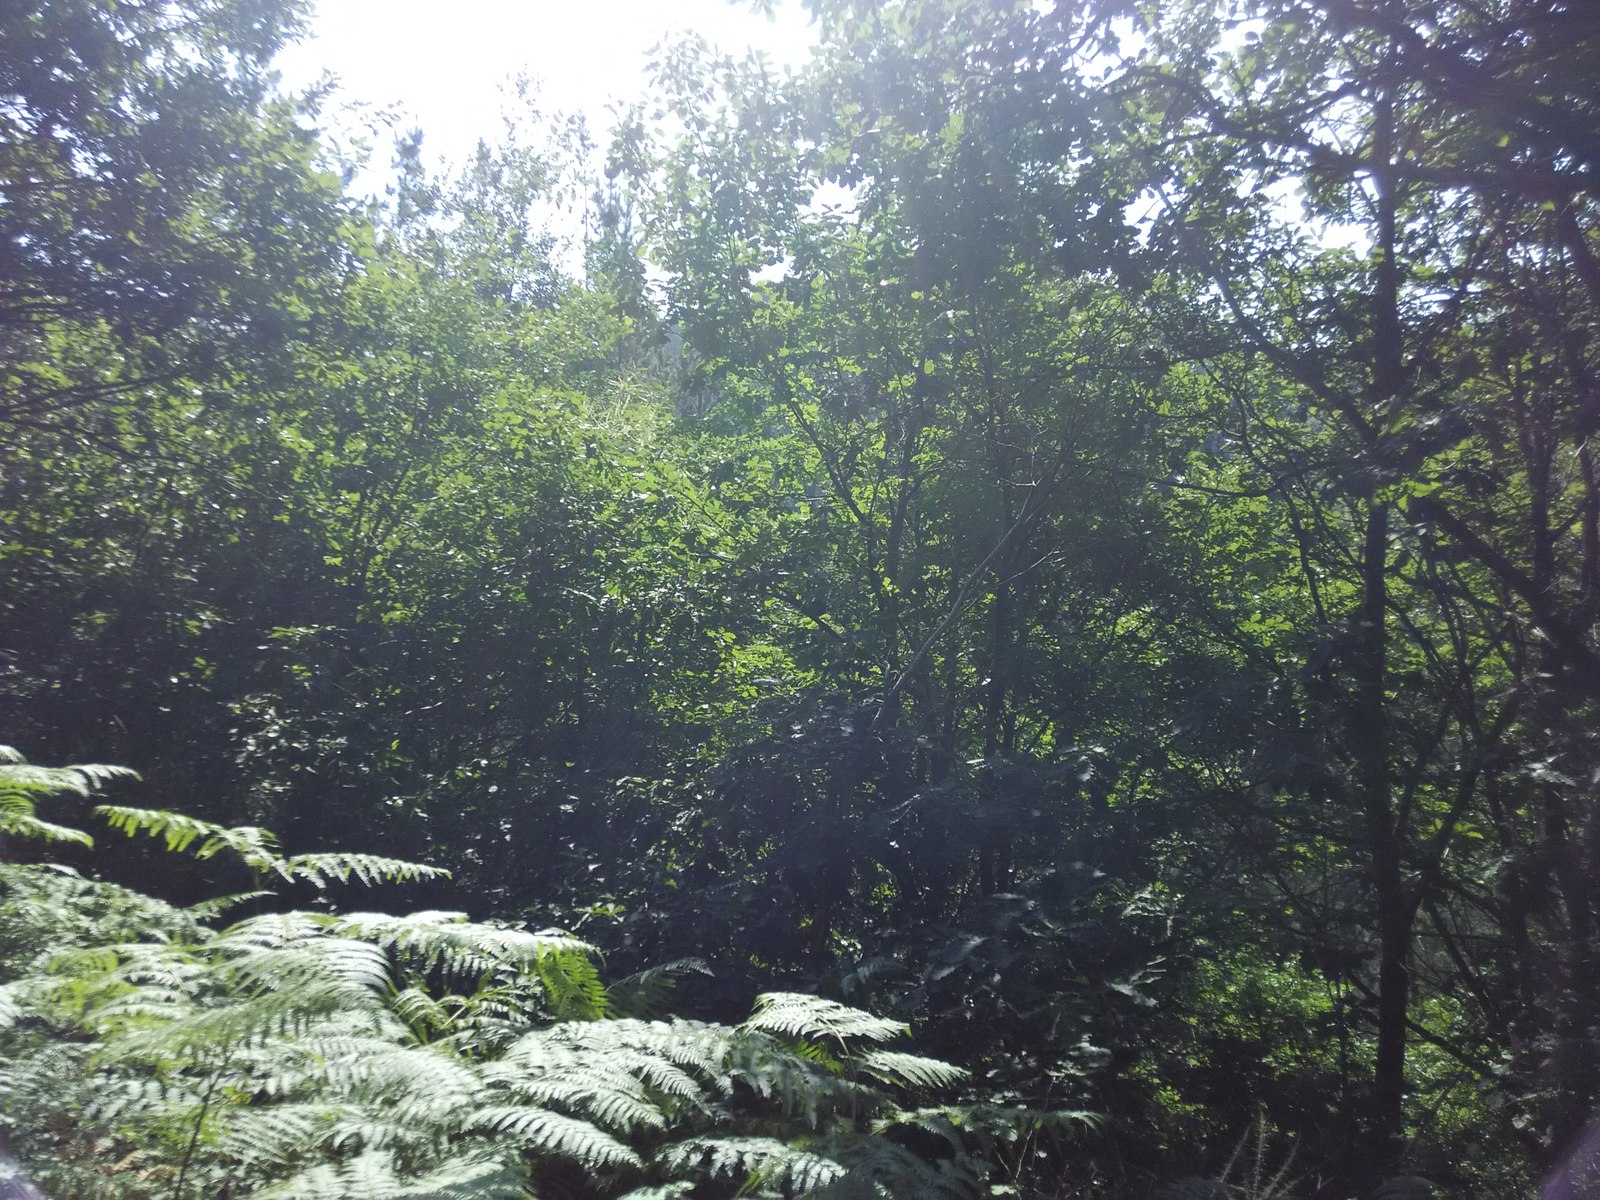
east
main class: Woodland
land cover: Other mixed woodland
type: broadleaved evergreen forest
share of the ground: > 75 %
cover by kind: coniferous forest trees 45 %, broadleaved forest trees 40 %, shrubs 15 %
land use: Forestry
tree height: > 5 m
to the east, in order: Other mixed woodland; Tracks; Pine dominated mixed woodland; Pine dominated coniferous woodland
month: June
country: ES
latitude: 43.0549
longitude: -2.4136
